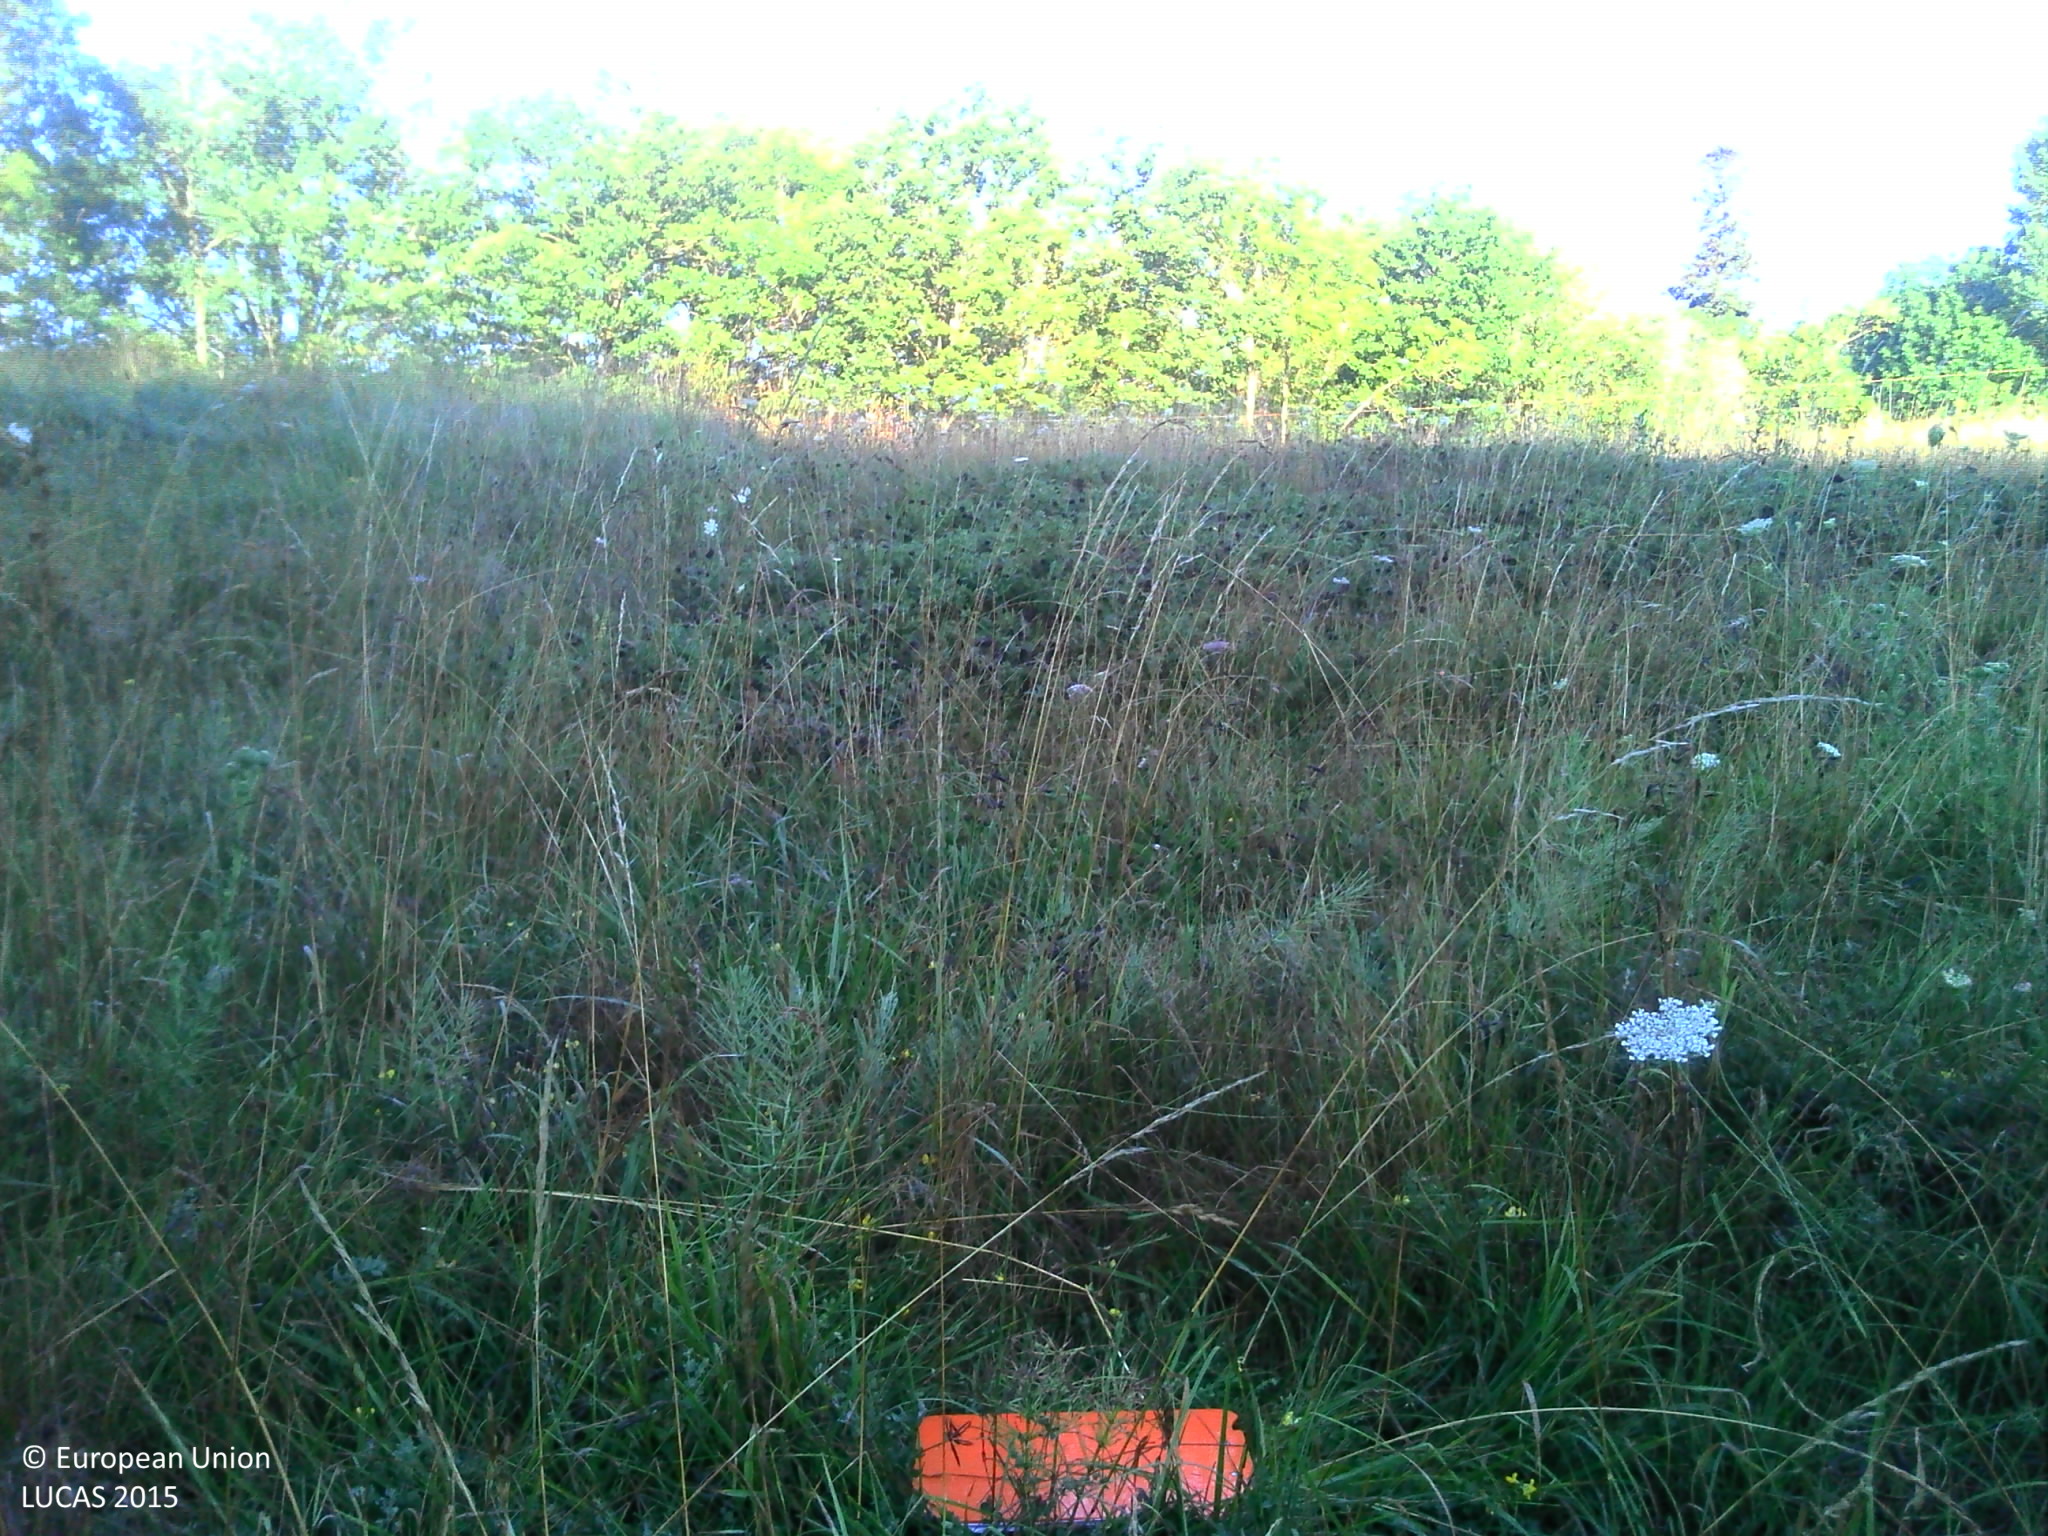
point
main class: Grassland
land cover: Grassland without tree/shrub cover
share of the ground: > 75 %
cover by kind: herbaceous plants 100 %
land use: Agriculture (excluding fallow land and kitchen gardens)
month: July
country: FR
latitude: 45.0523
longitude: 3.8203
